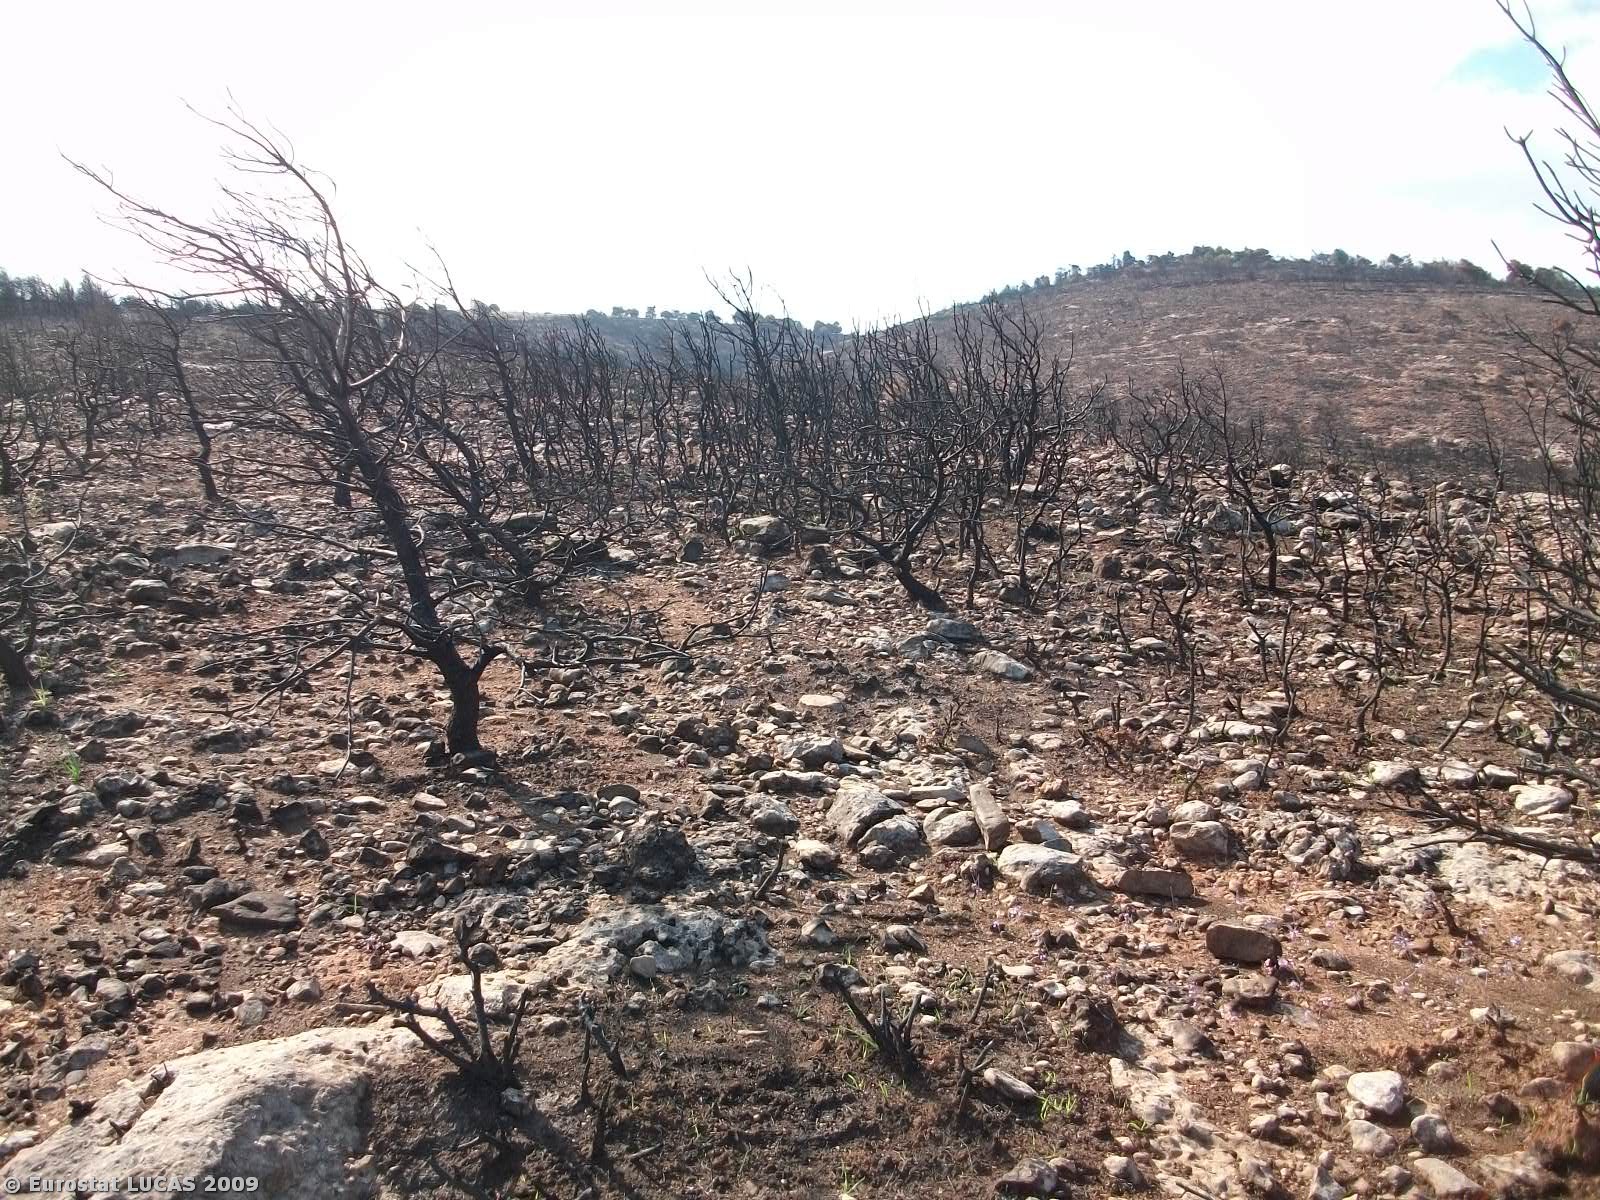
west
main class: Grassland
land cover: Grassland with sparse tree/shrub cover
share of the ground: 10 - 25 %
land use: Unused
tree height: < 5 m
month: September
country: GR
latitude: 38.2011
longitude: 23.9520
